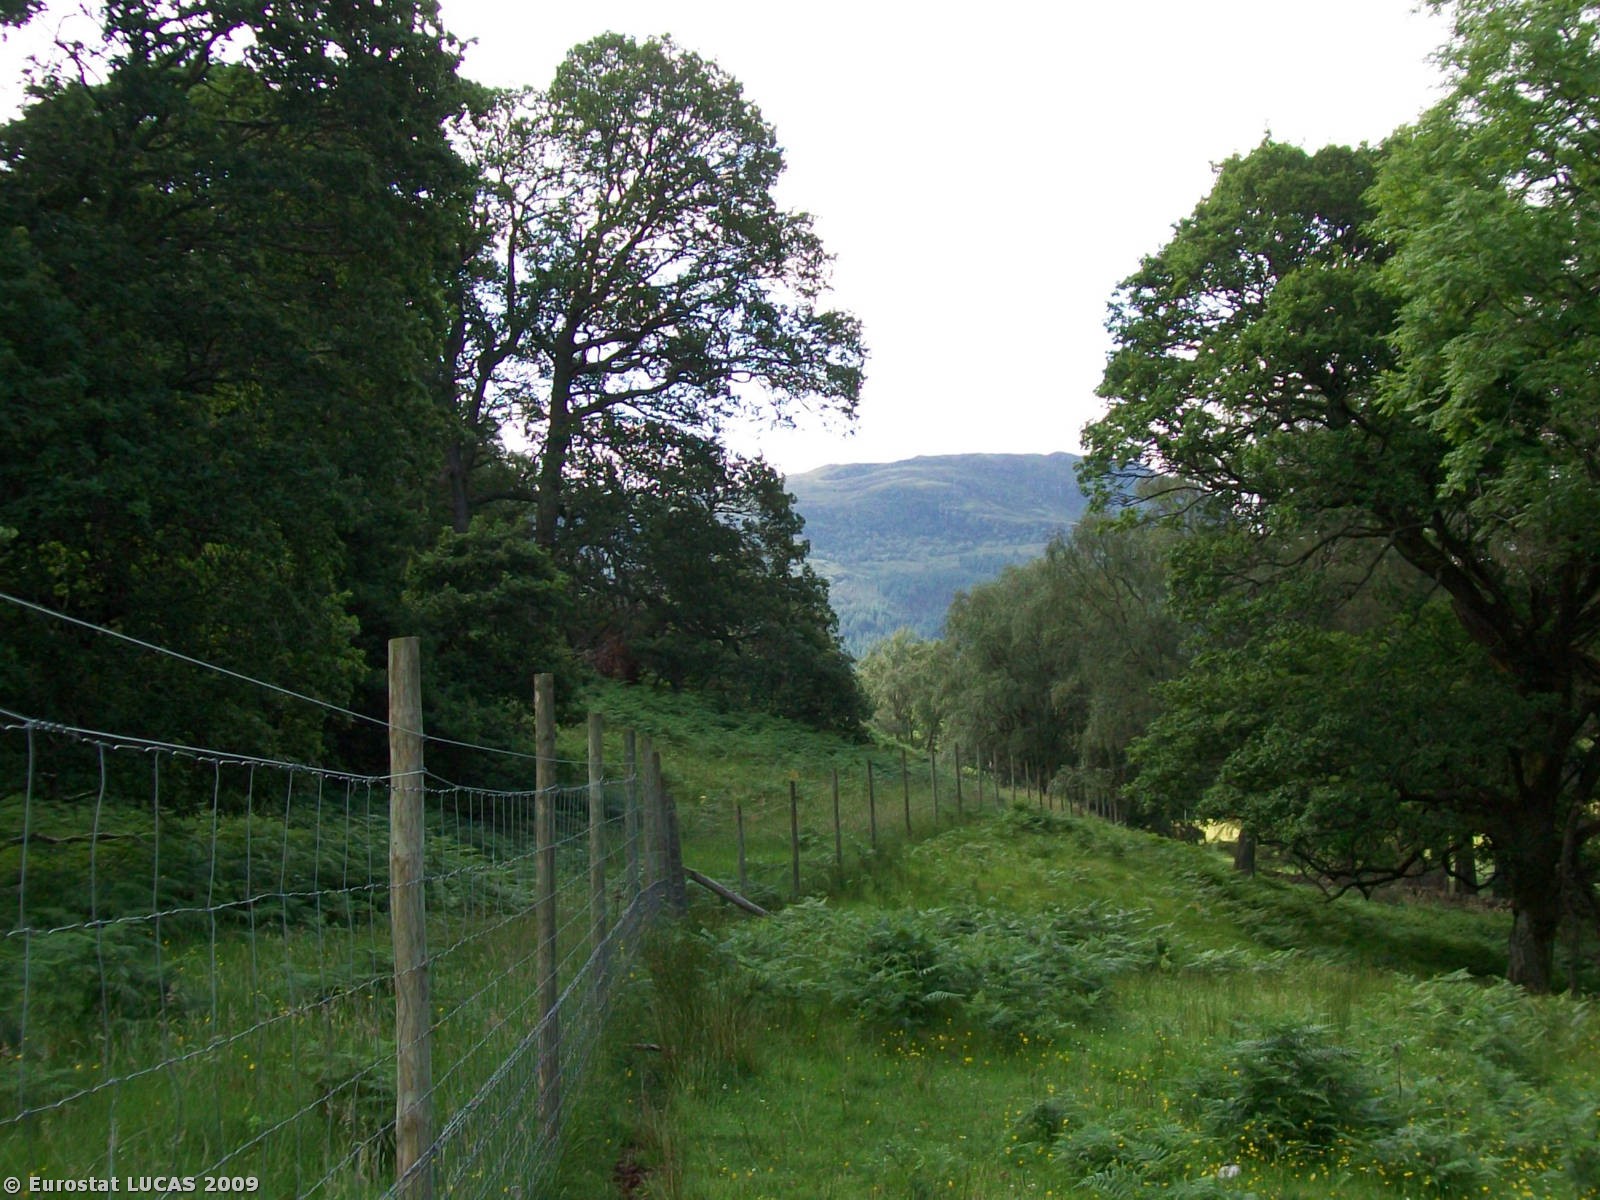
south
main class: Grassland
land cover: Grassland with sparse tree/shrub cover
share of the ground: > 75 %
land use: Forestry
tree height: > 5 m
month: July
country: GB
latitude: 57.8275
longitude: -5.1753
